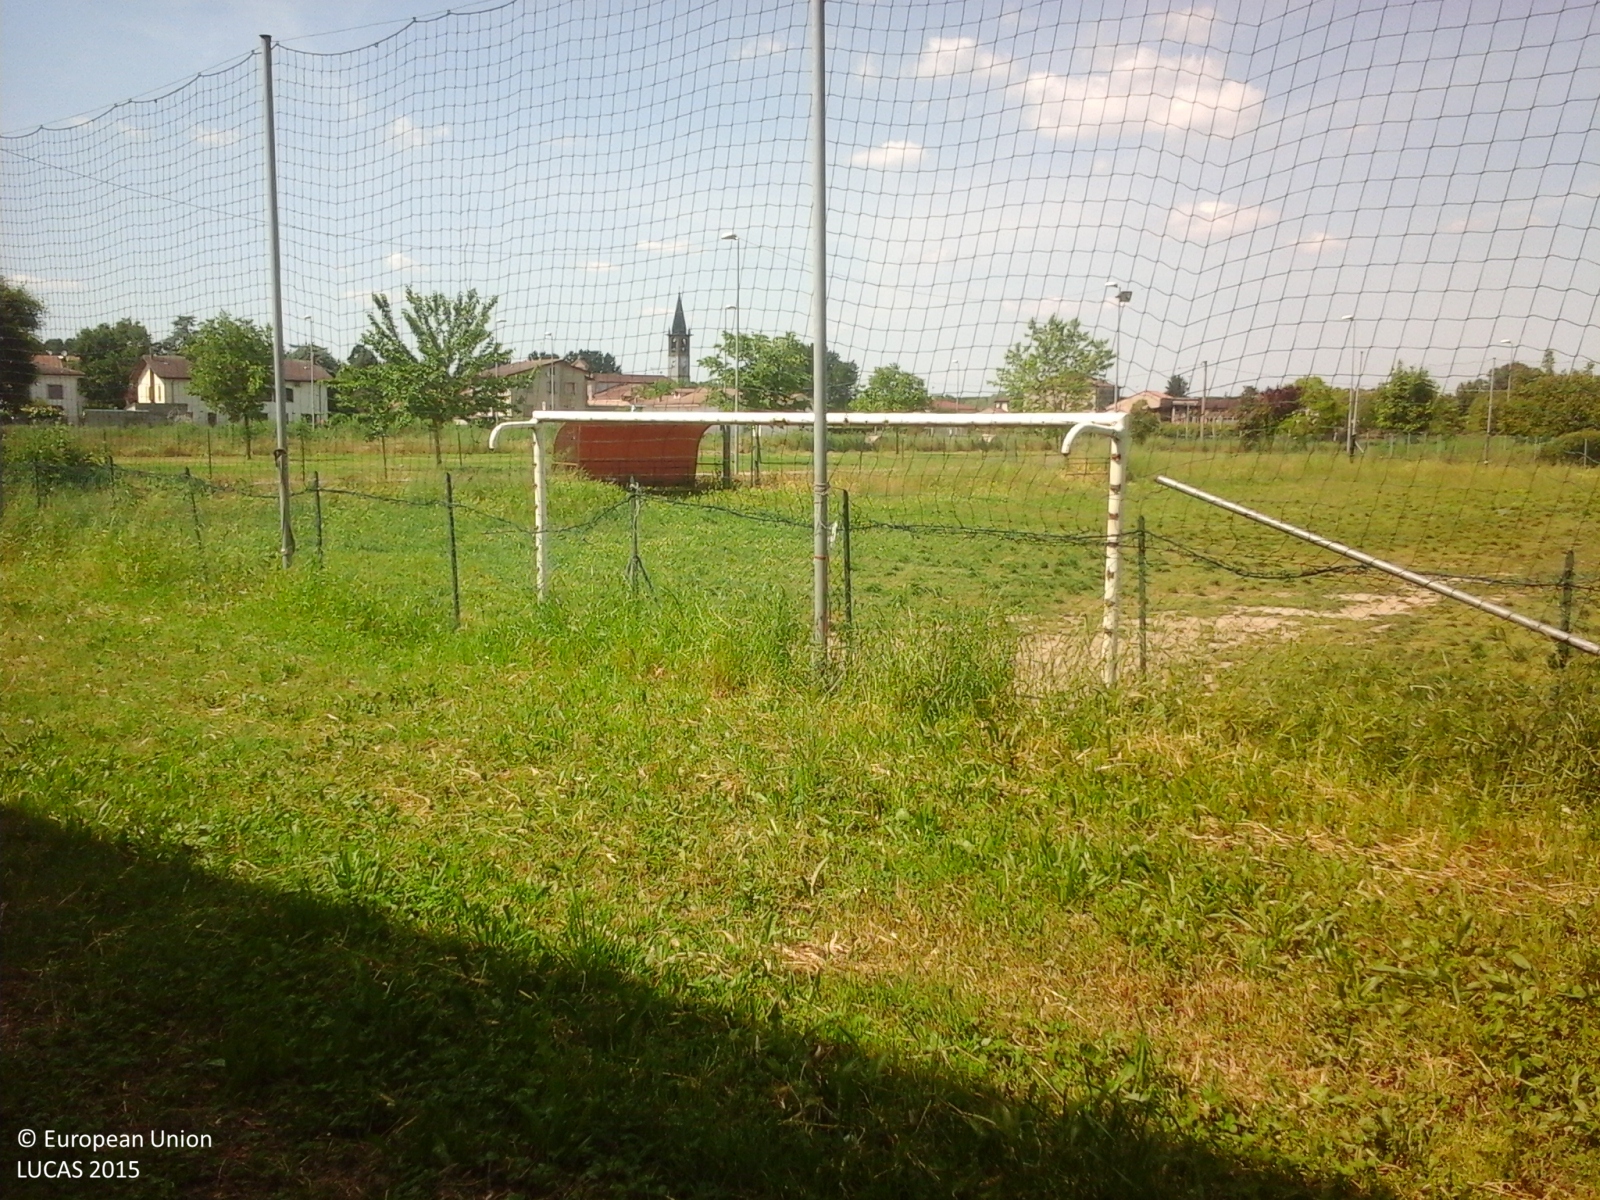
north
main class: Grassland
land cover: Grassland without tree/shrub cover
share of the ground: > 75 %
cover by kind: herbaceous plants 100 %
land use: Sport
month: May
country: IT
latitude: 45.0327
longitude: 10.7981
